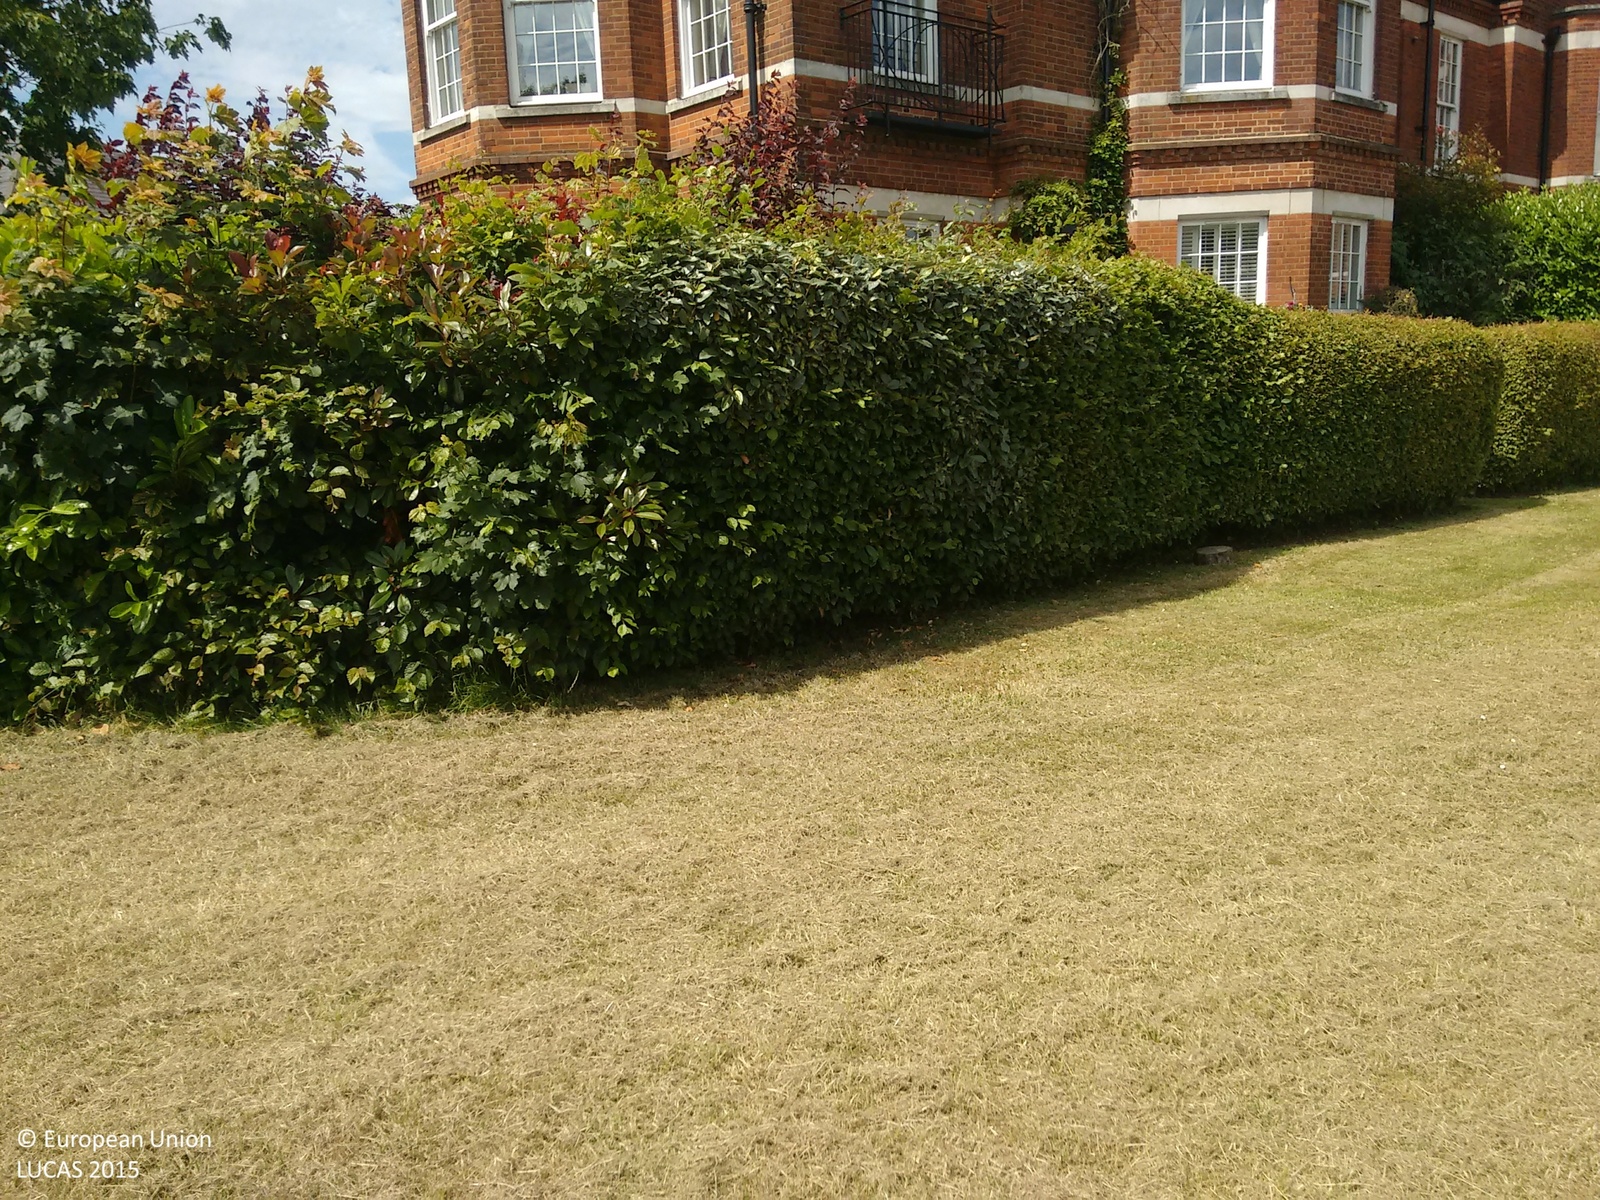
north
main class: Grassland
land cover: Grassland without tree/shrub cover
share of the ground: > 75 %
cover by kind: herbaceous plants 100 %
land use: Residential
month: June
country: GB
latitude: 51.2894
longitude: -0.1436
